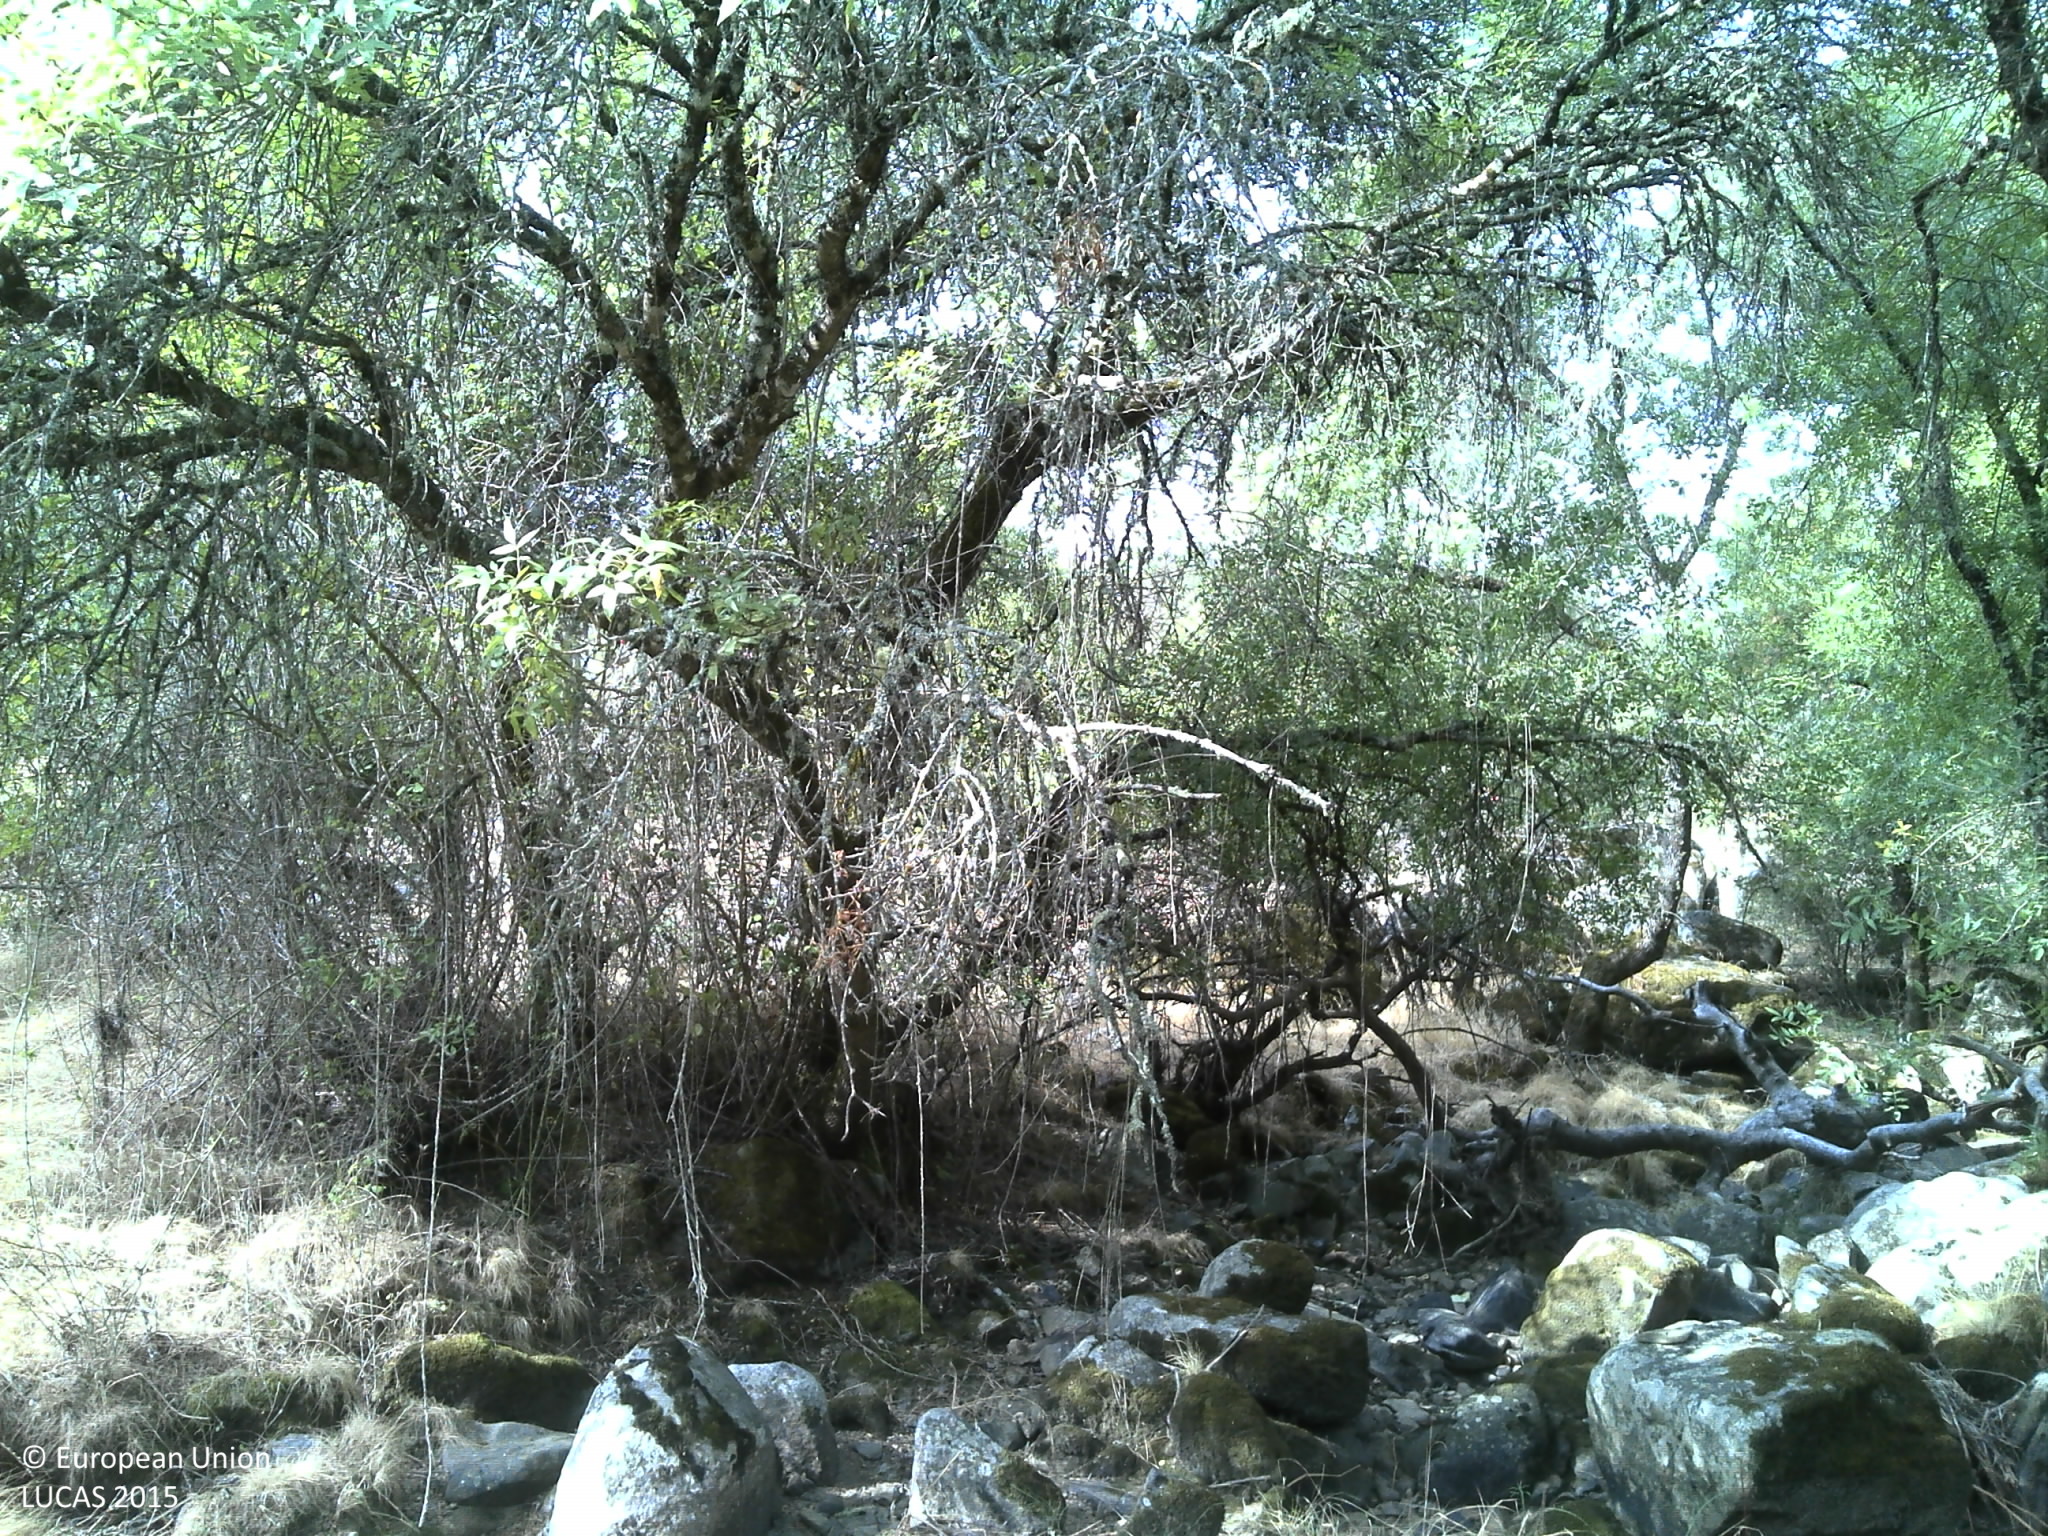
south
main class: Woodland
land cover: Broadleaved woodland
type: broadleaved evergreen forest
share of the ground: > 75 %
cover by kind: broadleaved forest trees 75 %, consolidated bare surface 25 %
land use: Forestry
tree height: > 5 m
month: August
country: PT
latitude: 39.2612
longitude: -7.5555
